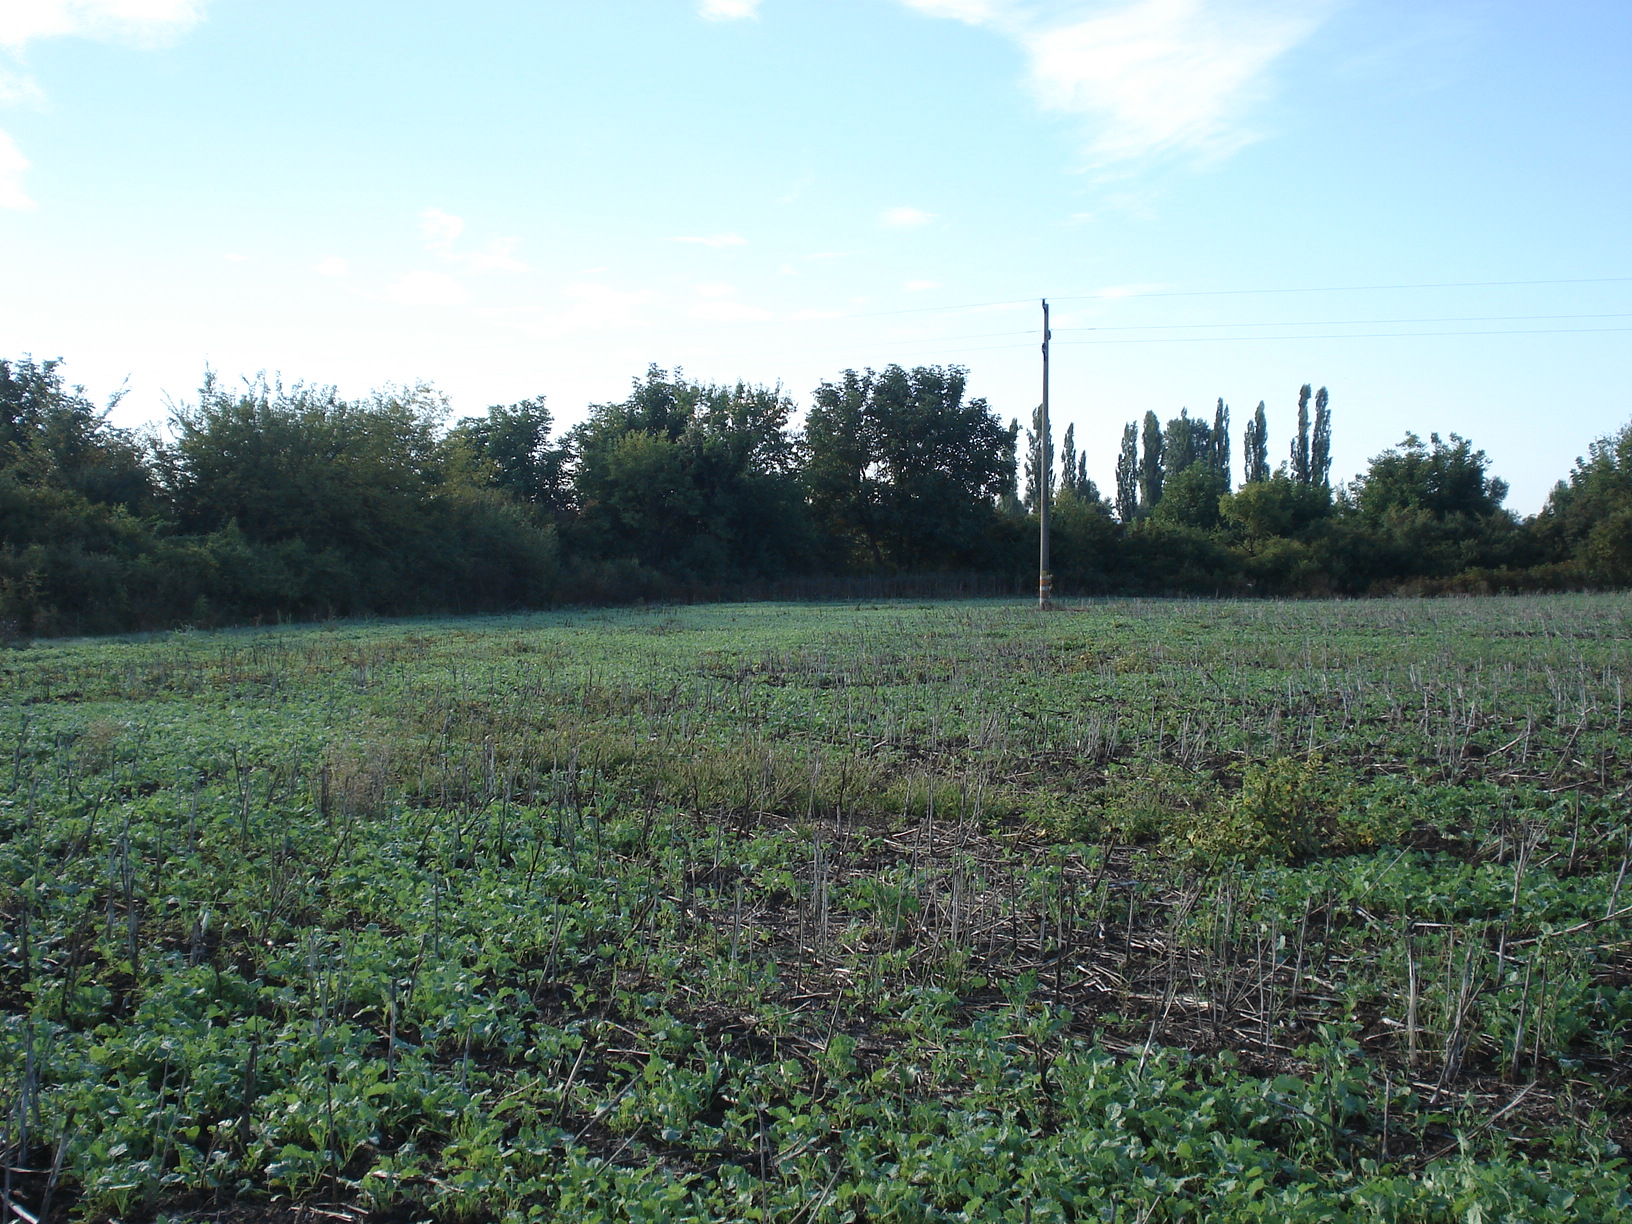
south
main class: Grassland
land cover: Spontaneously vegetated surfaces
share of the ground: > 75 %
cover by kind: herbaceous plants 80 %, unconsolidated bare surface 20 %
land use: Agriculture (excluding fallow land and kitchen gardens)
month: September
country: BG
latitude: 43.2505
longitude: 25.2605
